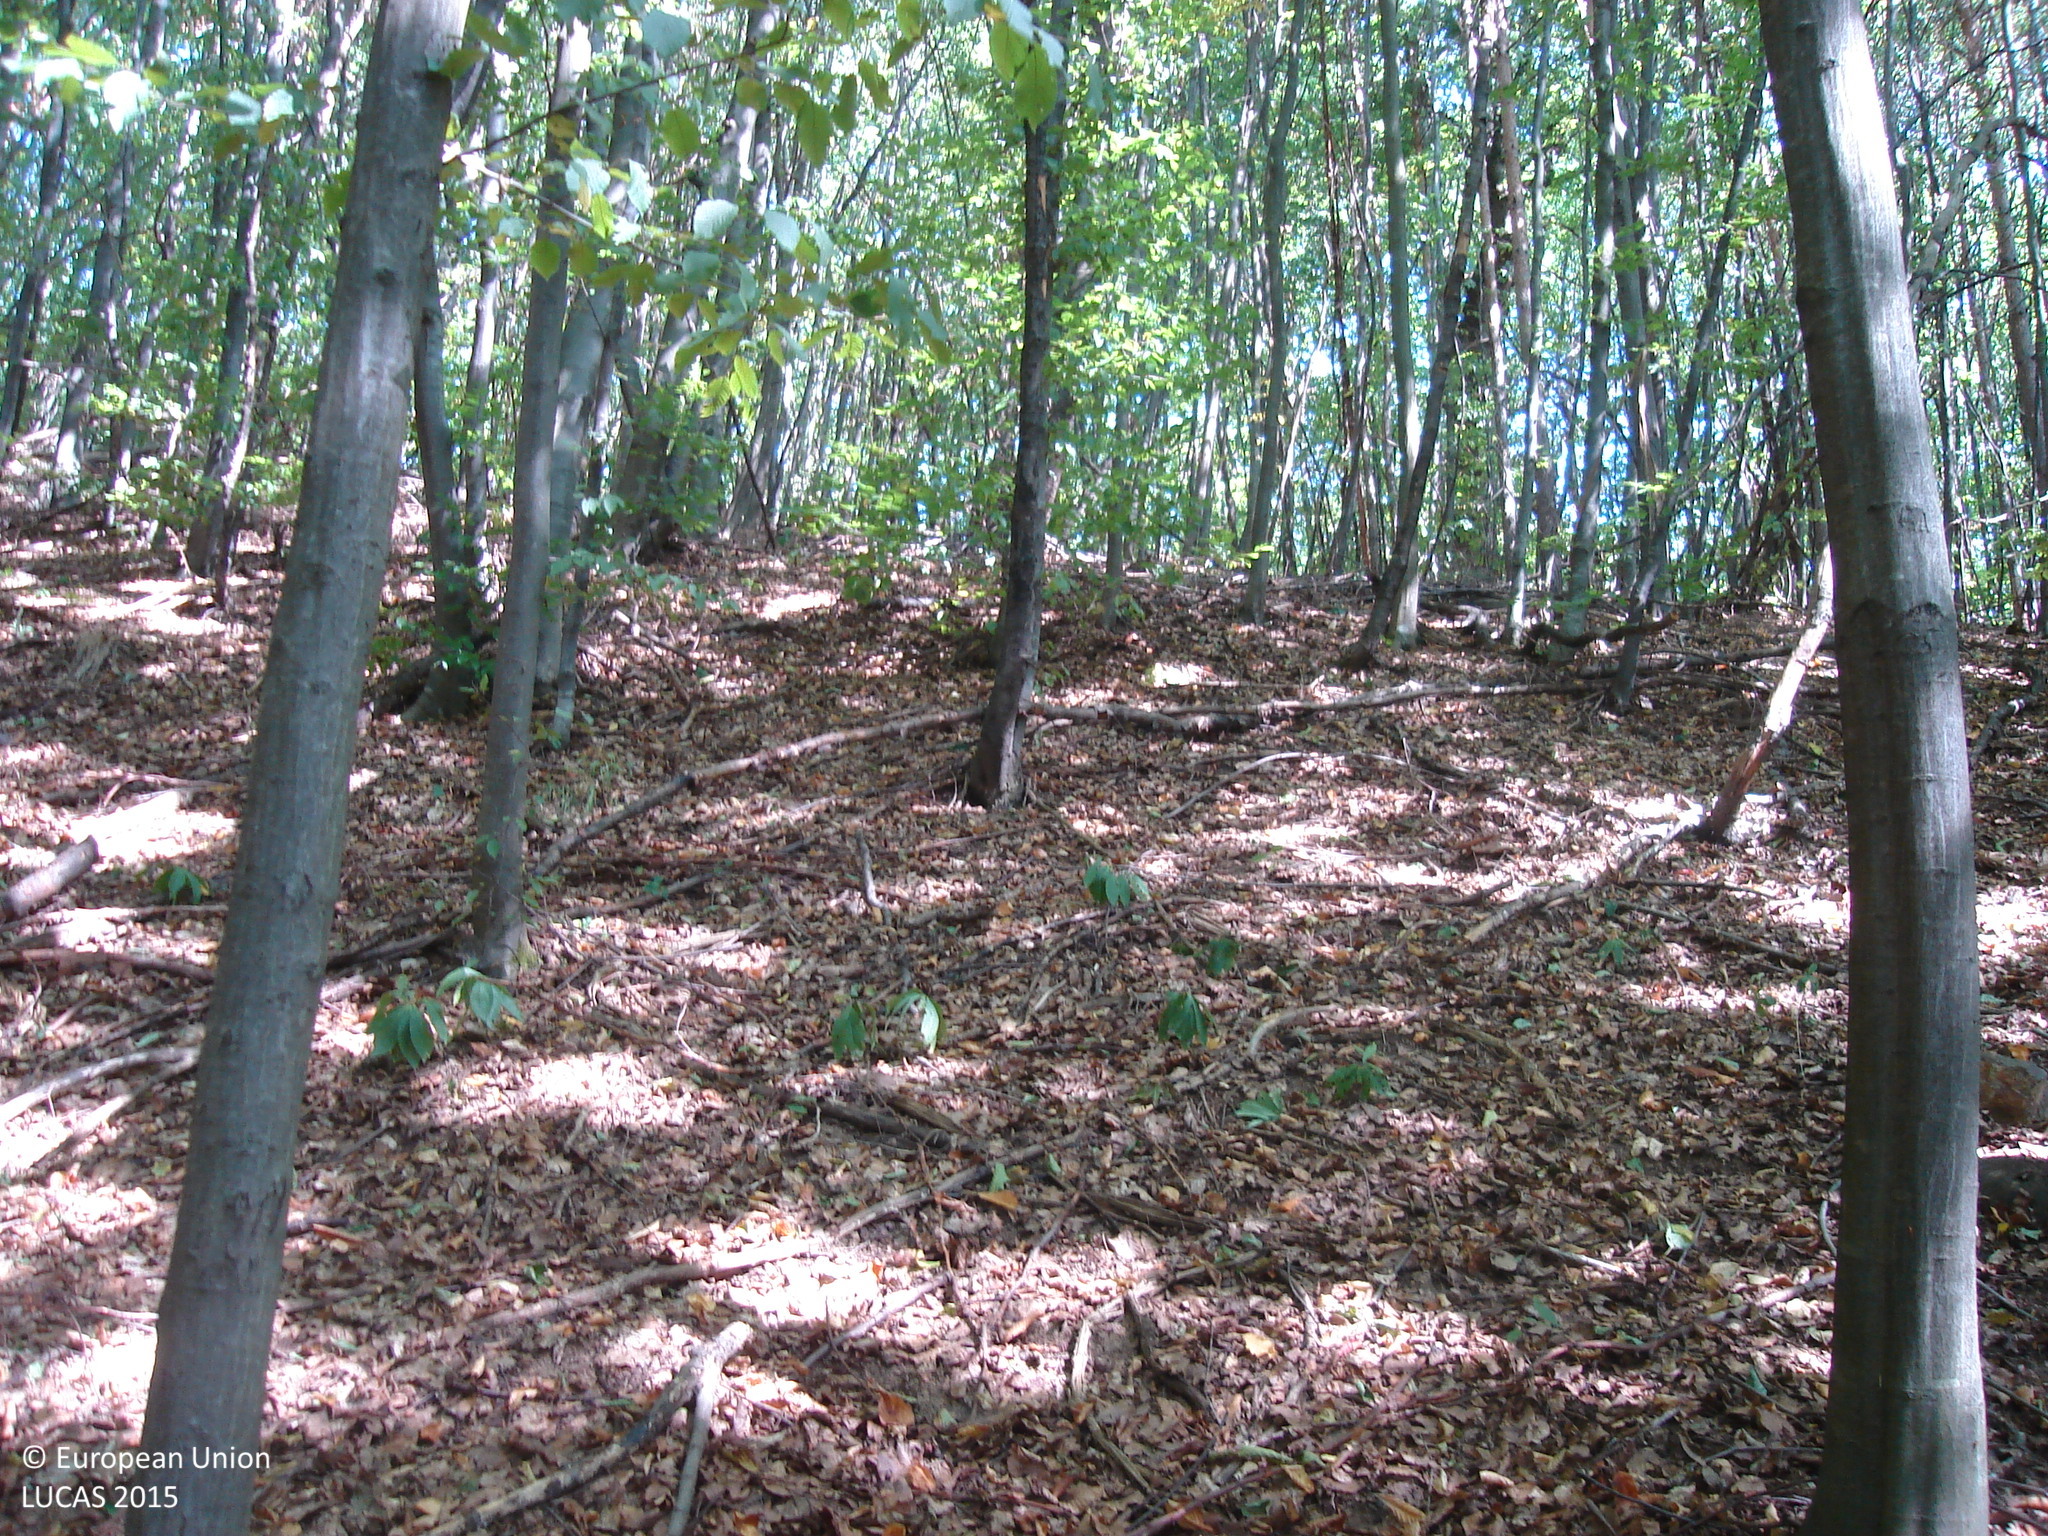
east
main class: Woodland
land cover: Broadleaved woodland
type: beech forest
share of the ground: > 75 %
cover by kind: broadleaved forest trees 80 %, consolidated bare surface 20 %
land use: Forestry
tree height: > 5 m
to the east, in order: Broadleaved woodland; Tracks; Broadleaved woodland
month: September
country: BG
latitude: 42.8108
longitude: 23.9995
